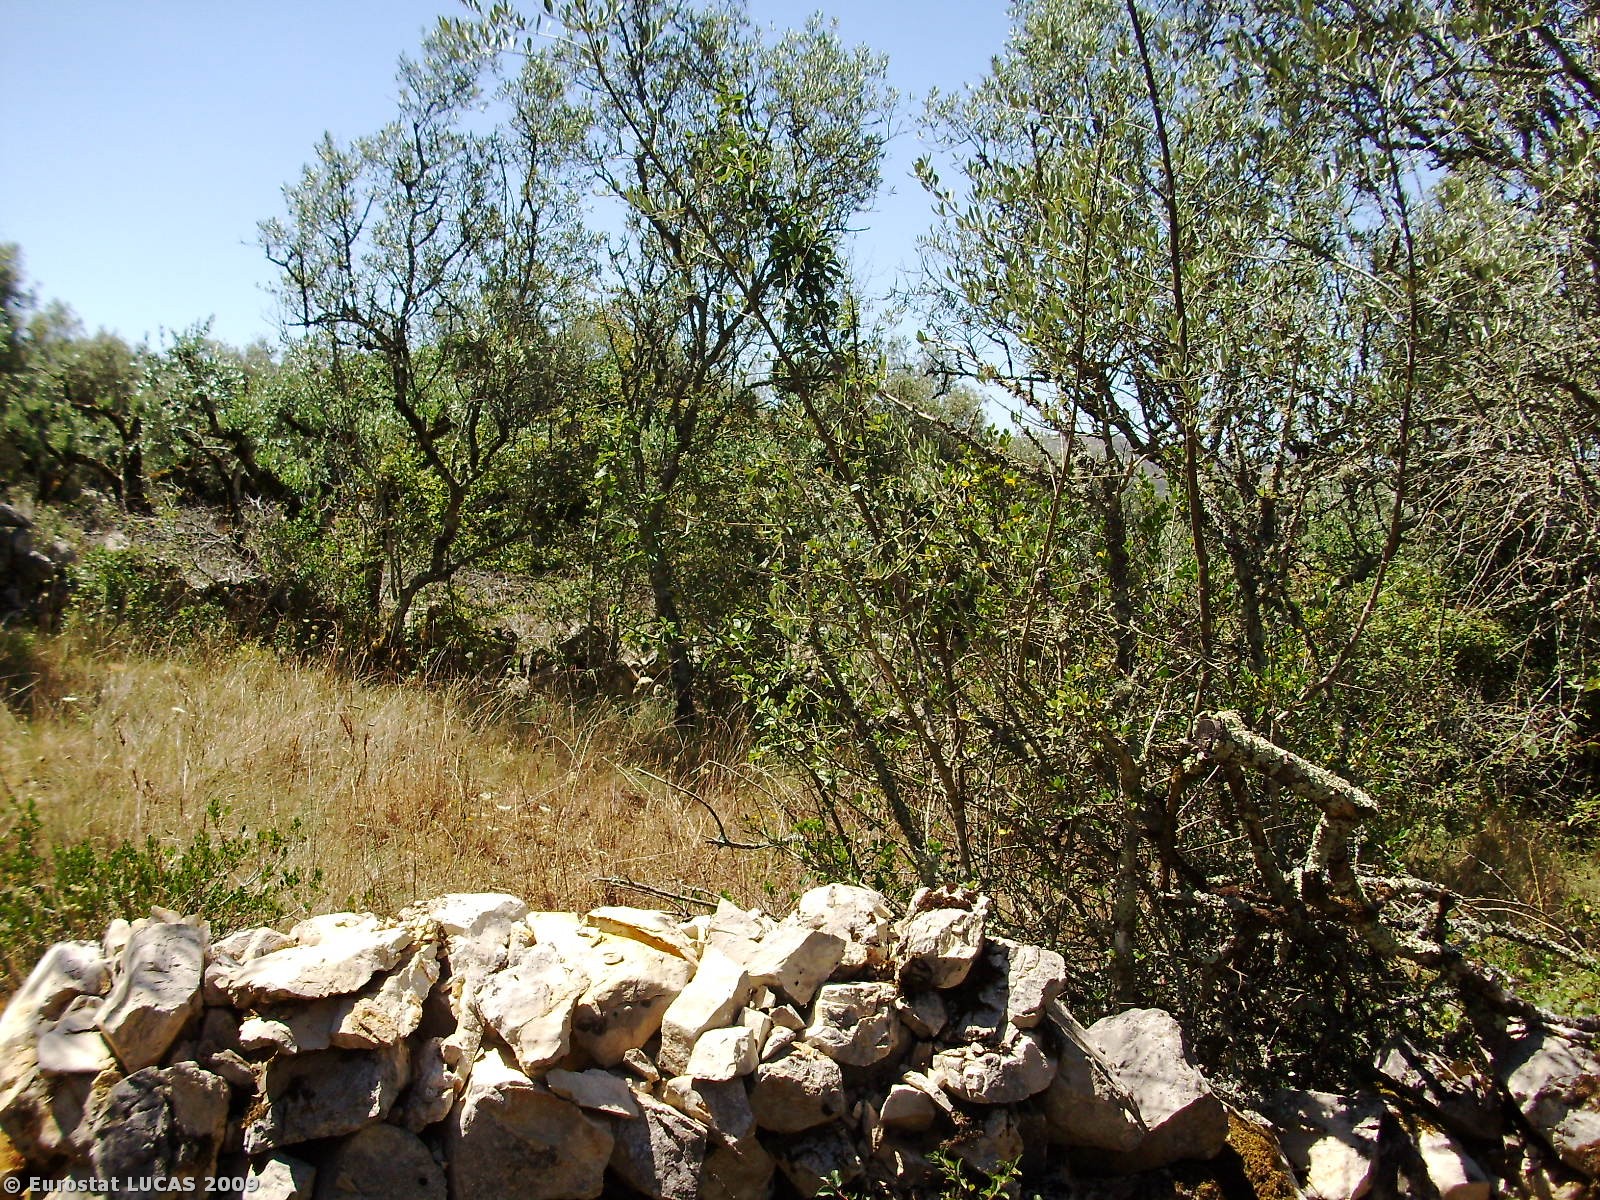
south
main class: Cropland
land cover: Olive groves
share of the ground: 25 - 50 %
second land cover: Spontaneously vegetated surfaces
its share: 50 - 75 %
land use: Agriculture (excluding fallow land and kitchen gardens)
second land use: Fallow land
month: July
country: PT
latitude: 39.5106
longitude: -8.8667
